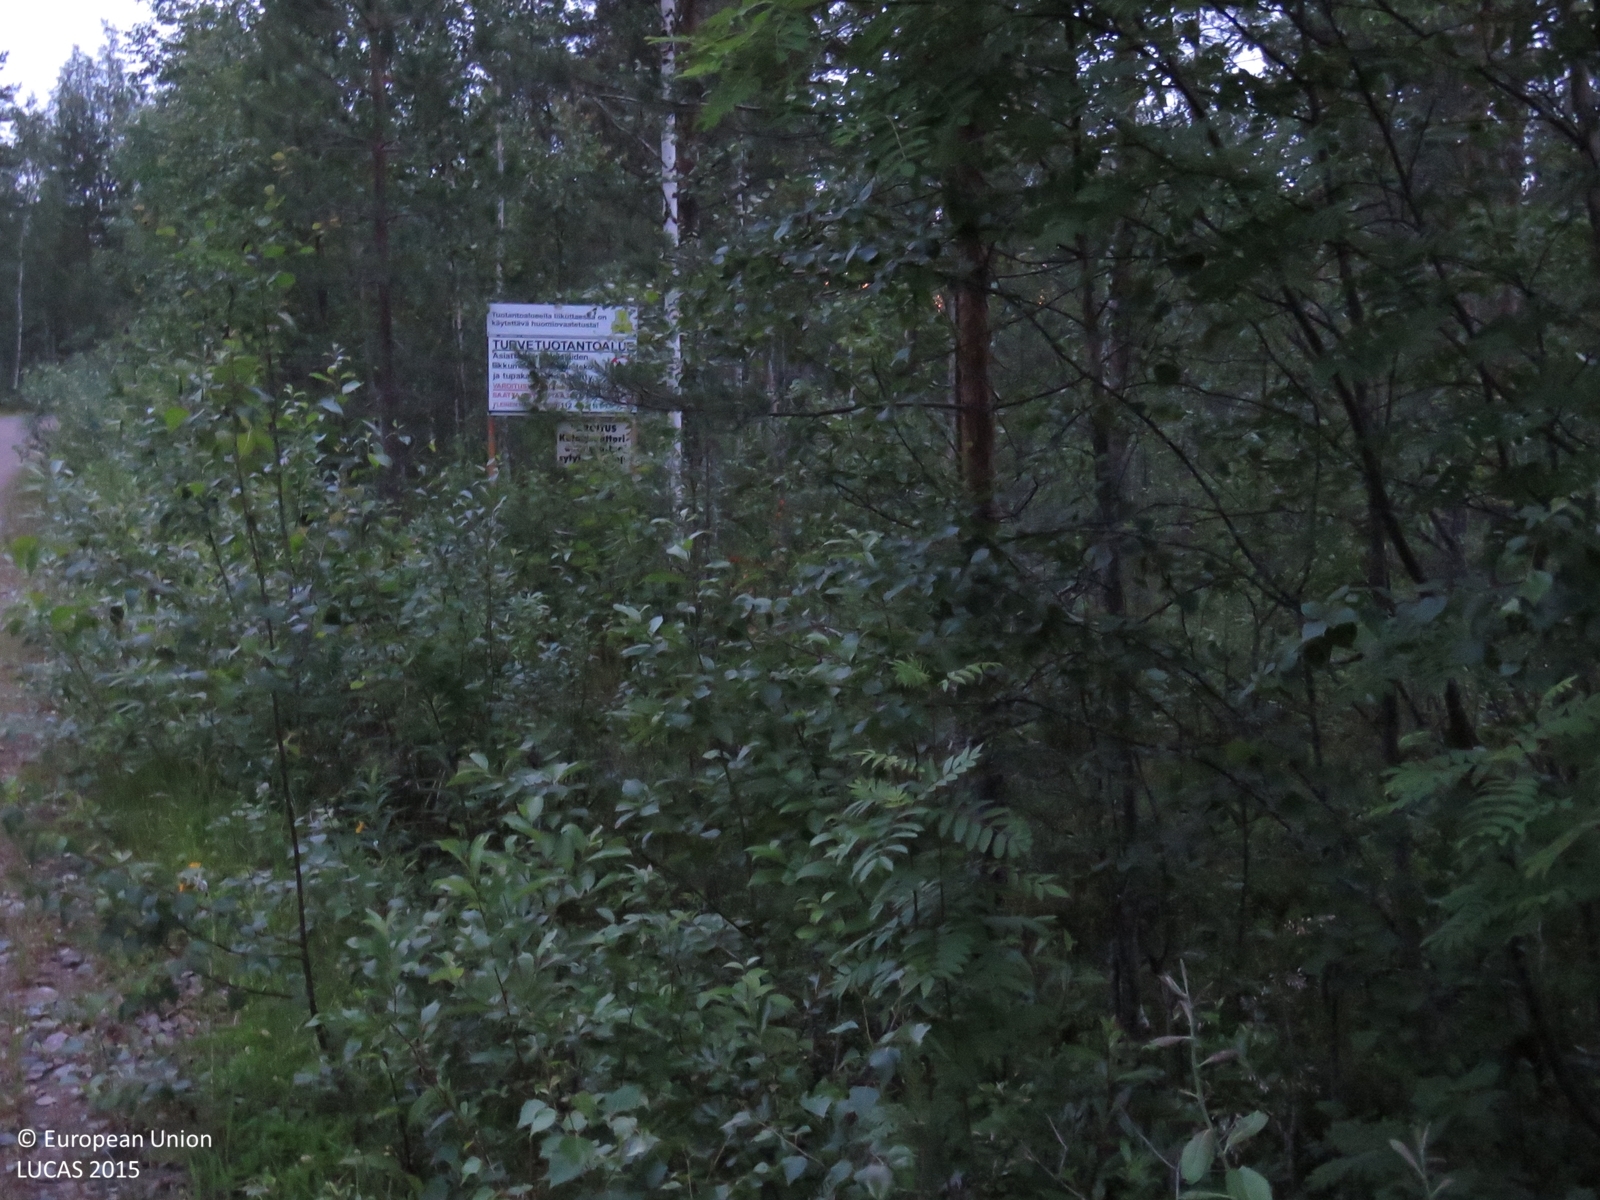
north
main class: Woodland
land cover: Pine dominated mixed woodland
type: boreal forest
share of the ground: 50 - 75 %
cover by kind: coniferous forest trees 40 %, broadleaved forest trees 30 %, shrubs 25 %, lichens and mosses 5 %
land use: Forestry
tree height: > 5 m
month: July
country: FI
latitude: 64.3247
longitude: 26.4789
